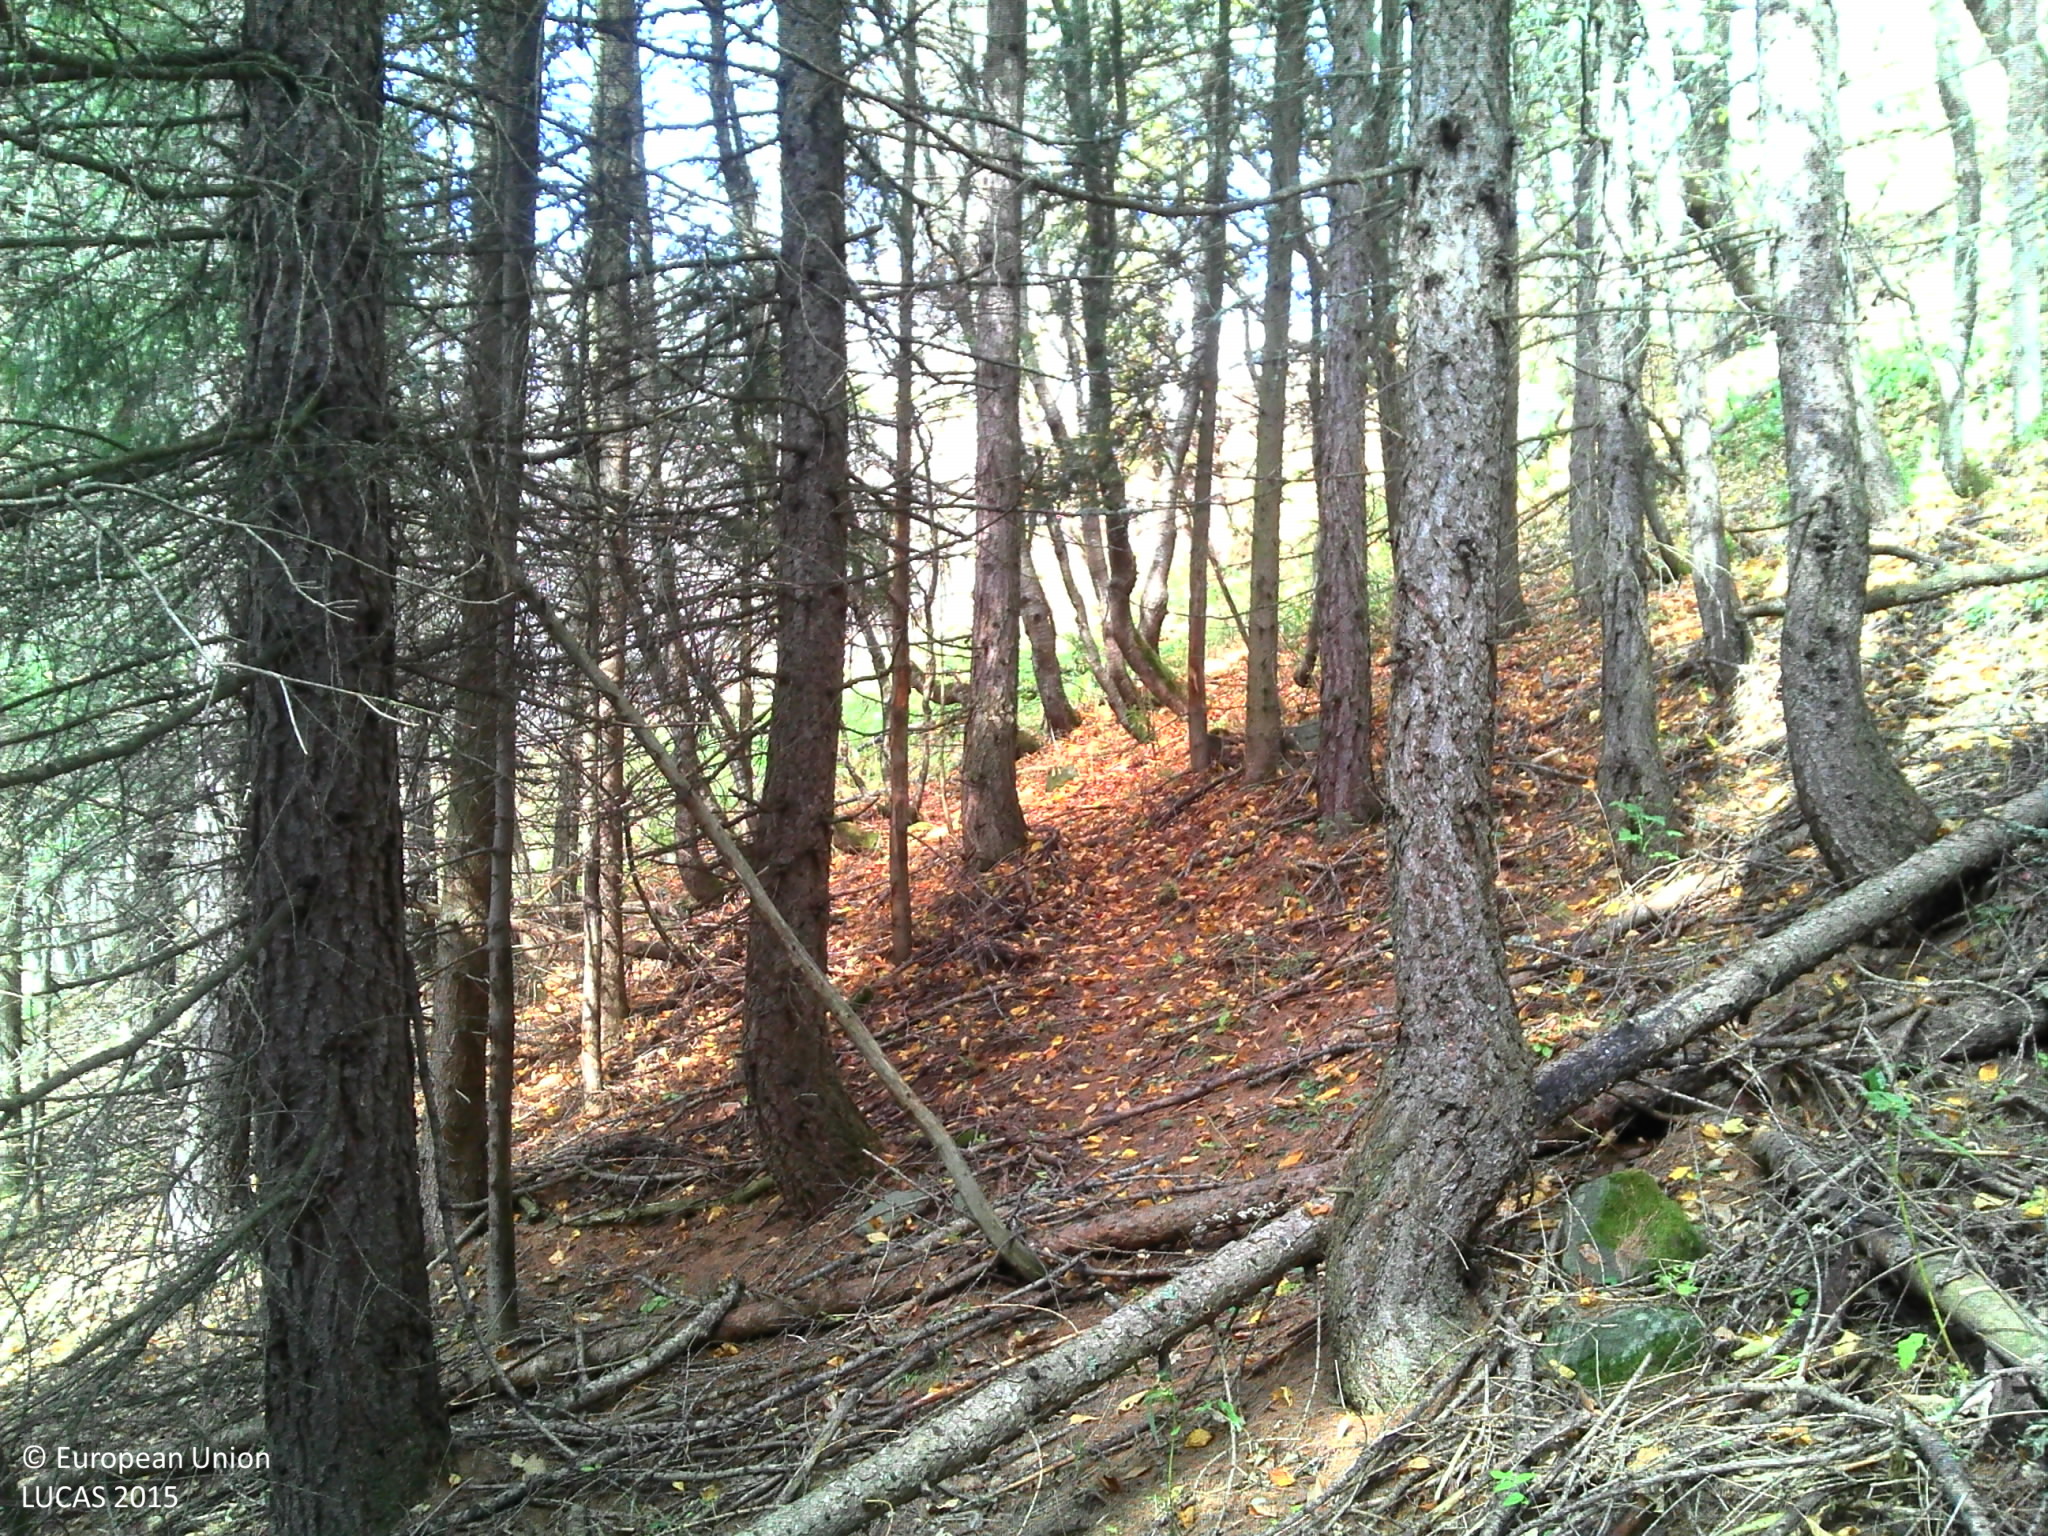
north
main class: Woodland
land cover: Other mixed woodland
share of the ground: > 75 %
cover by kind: coniferous forest trees 50 %, broadleaved forest trees 30 %, unconsolidated bare surface 15 %, shrubs 5 %
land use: Forestry
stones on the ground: < 10 %
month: October
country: FR
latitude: 45.1735
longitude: 6.4297
